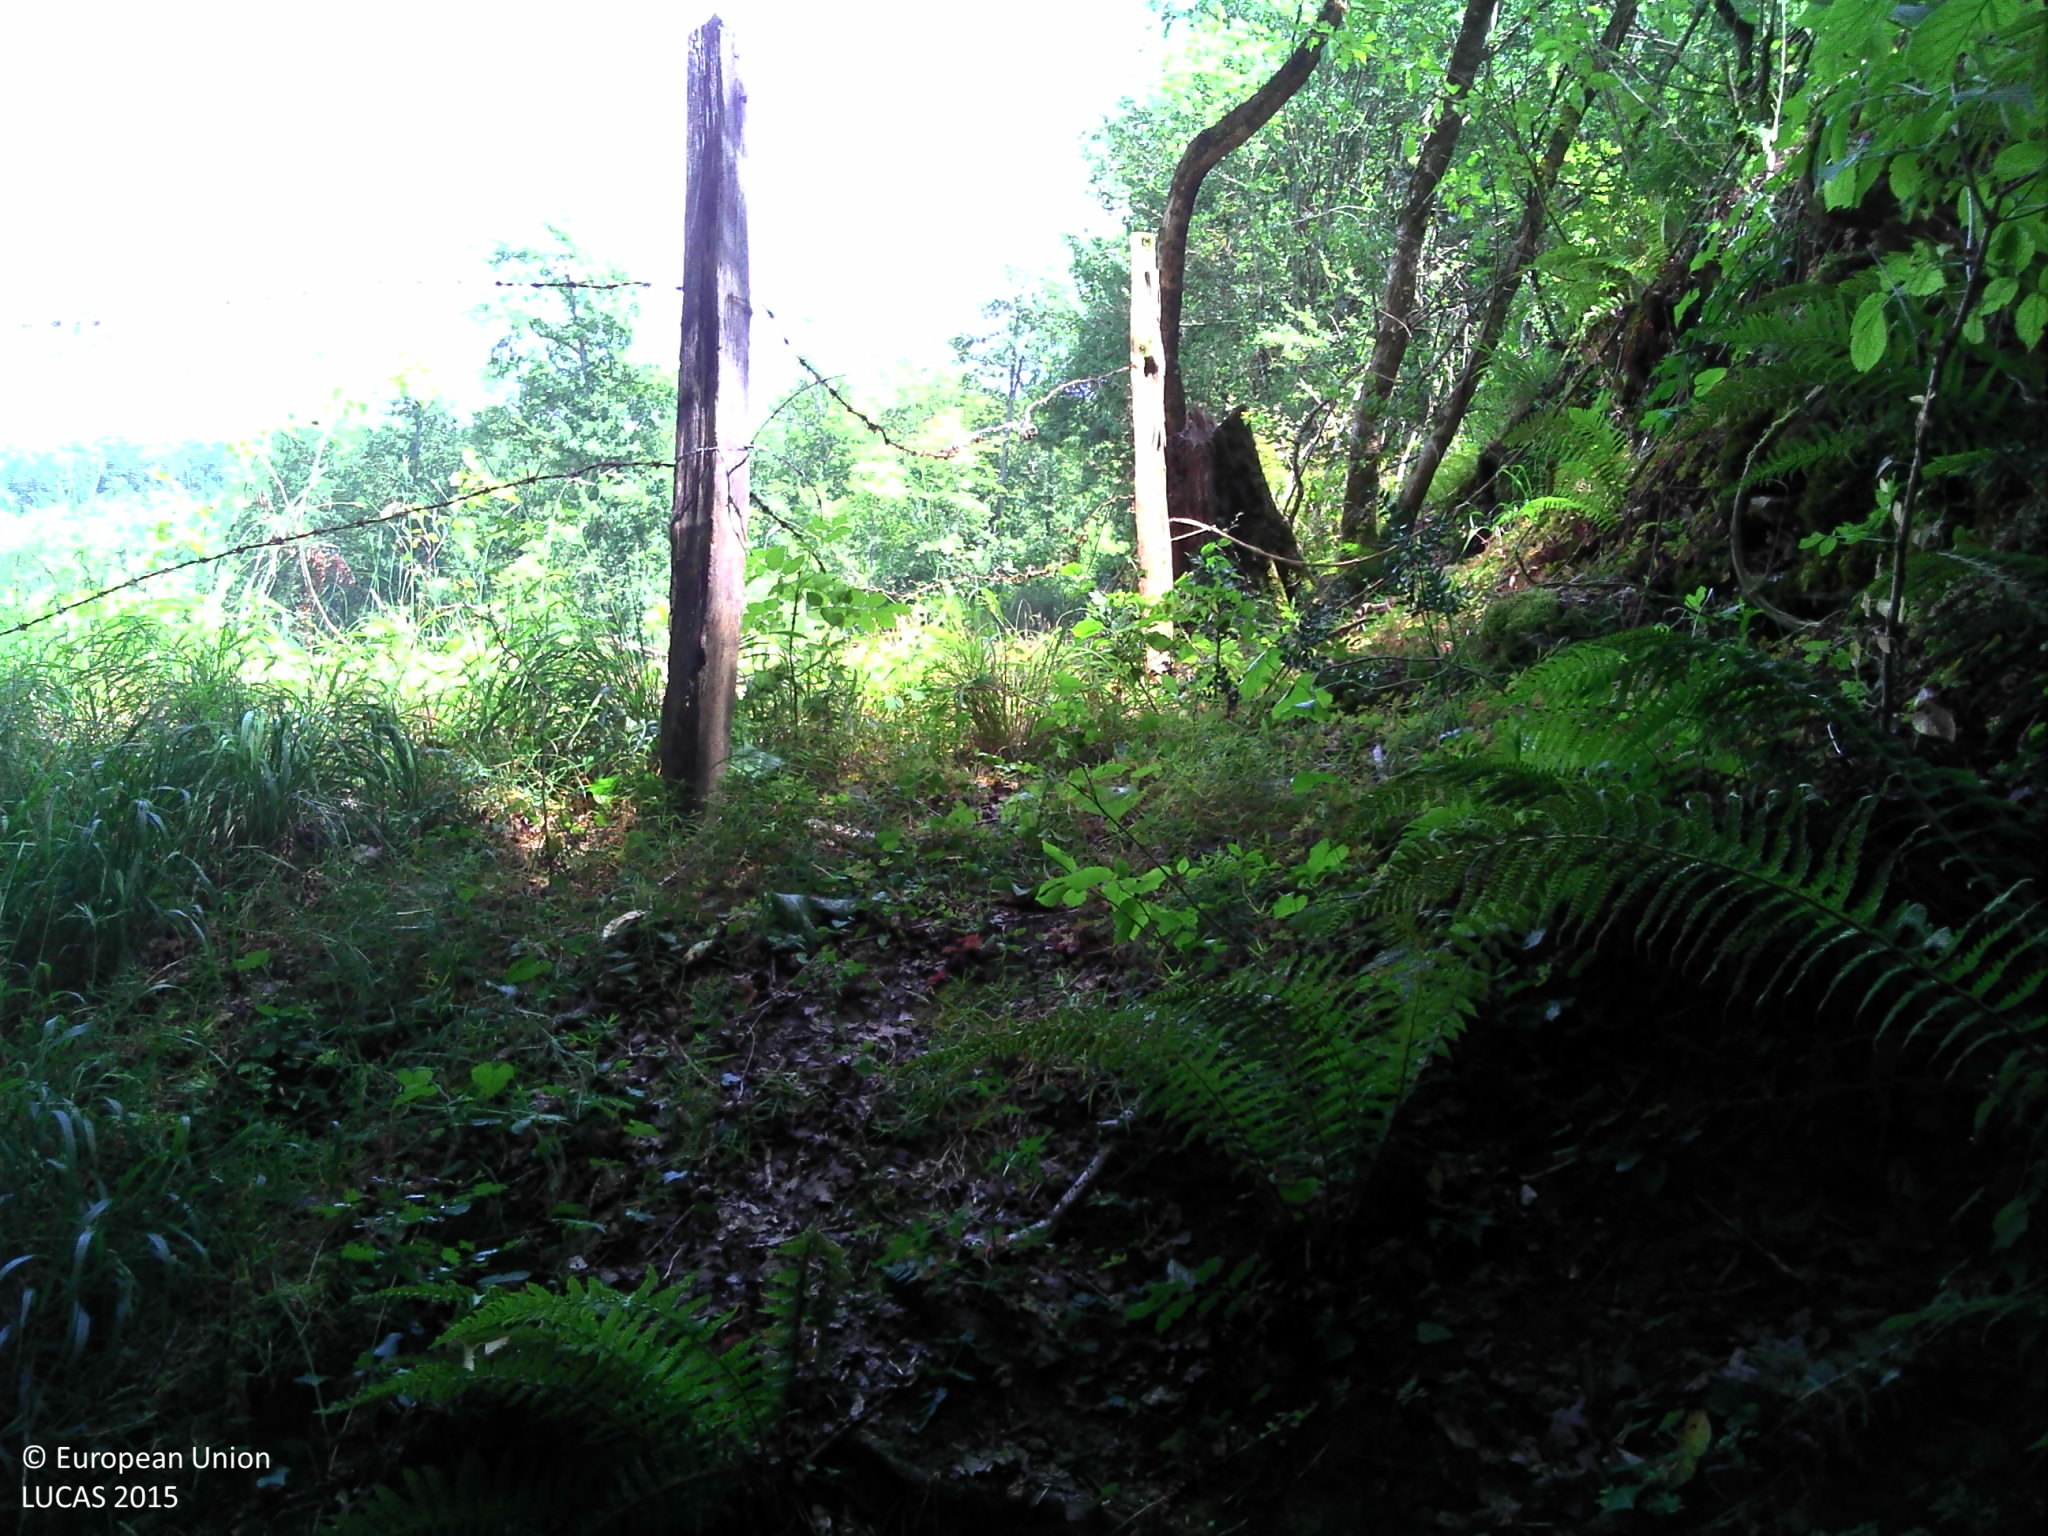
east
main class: Woodland
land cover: Broadleaved woodland
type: acidophilous oak and oak-birch forest
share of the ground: > 75 %
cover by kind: broadleaved forest trees 50 %, shrubs 20 %, herbaceous plants 20 %, consolidated bare surface 10 %
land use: Forestry
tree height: > 5 m
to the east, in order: Broadleaved woodland; Fences; Grassland without tree/shrub cover; Fences; Broadleaved woodland; Tracks; Broadleaved woodland; Tracks; Broadleaved woodland
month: July
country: FR
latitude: 43.0725
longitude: 0.8286
